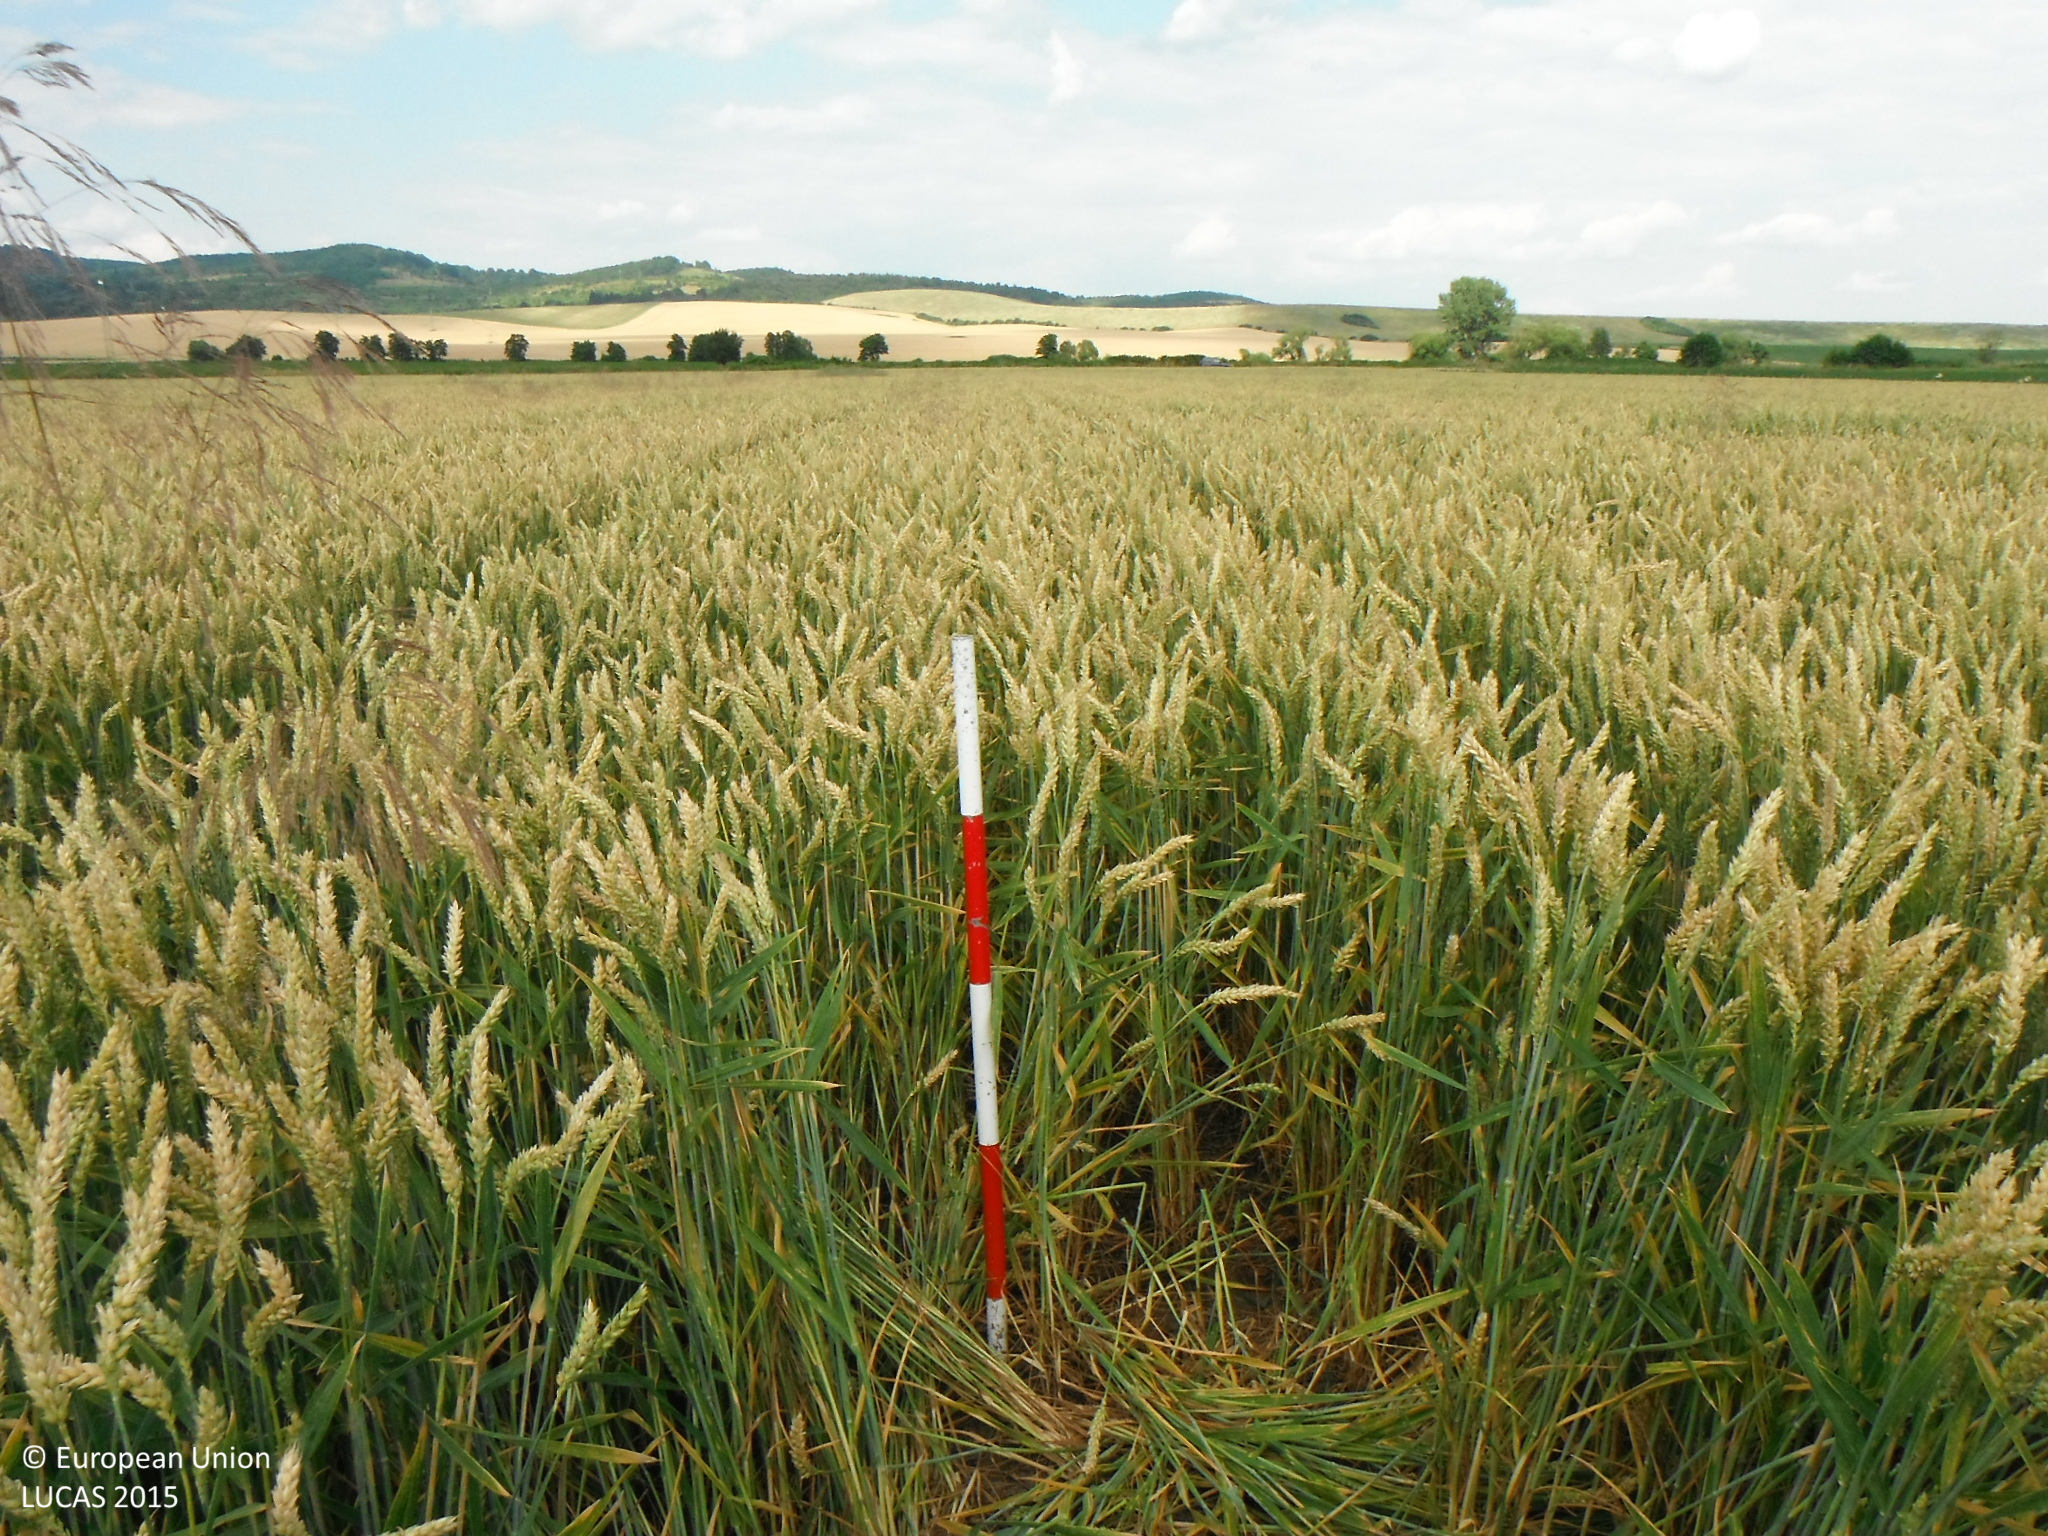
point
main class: Cropland
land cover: Common wheat
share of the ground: > 75 %
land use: Agriculture (excluding fallow land and kitchen gardens)
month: June
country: SK
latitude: 48.4270
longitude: 20.1258
